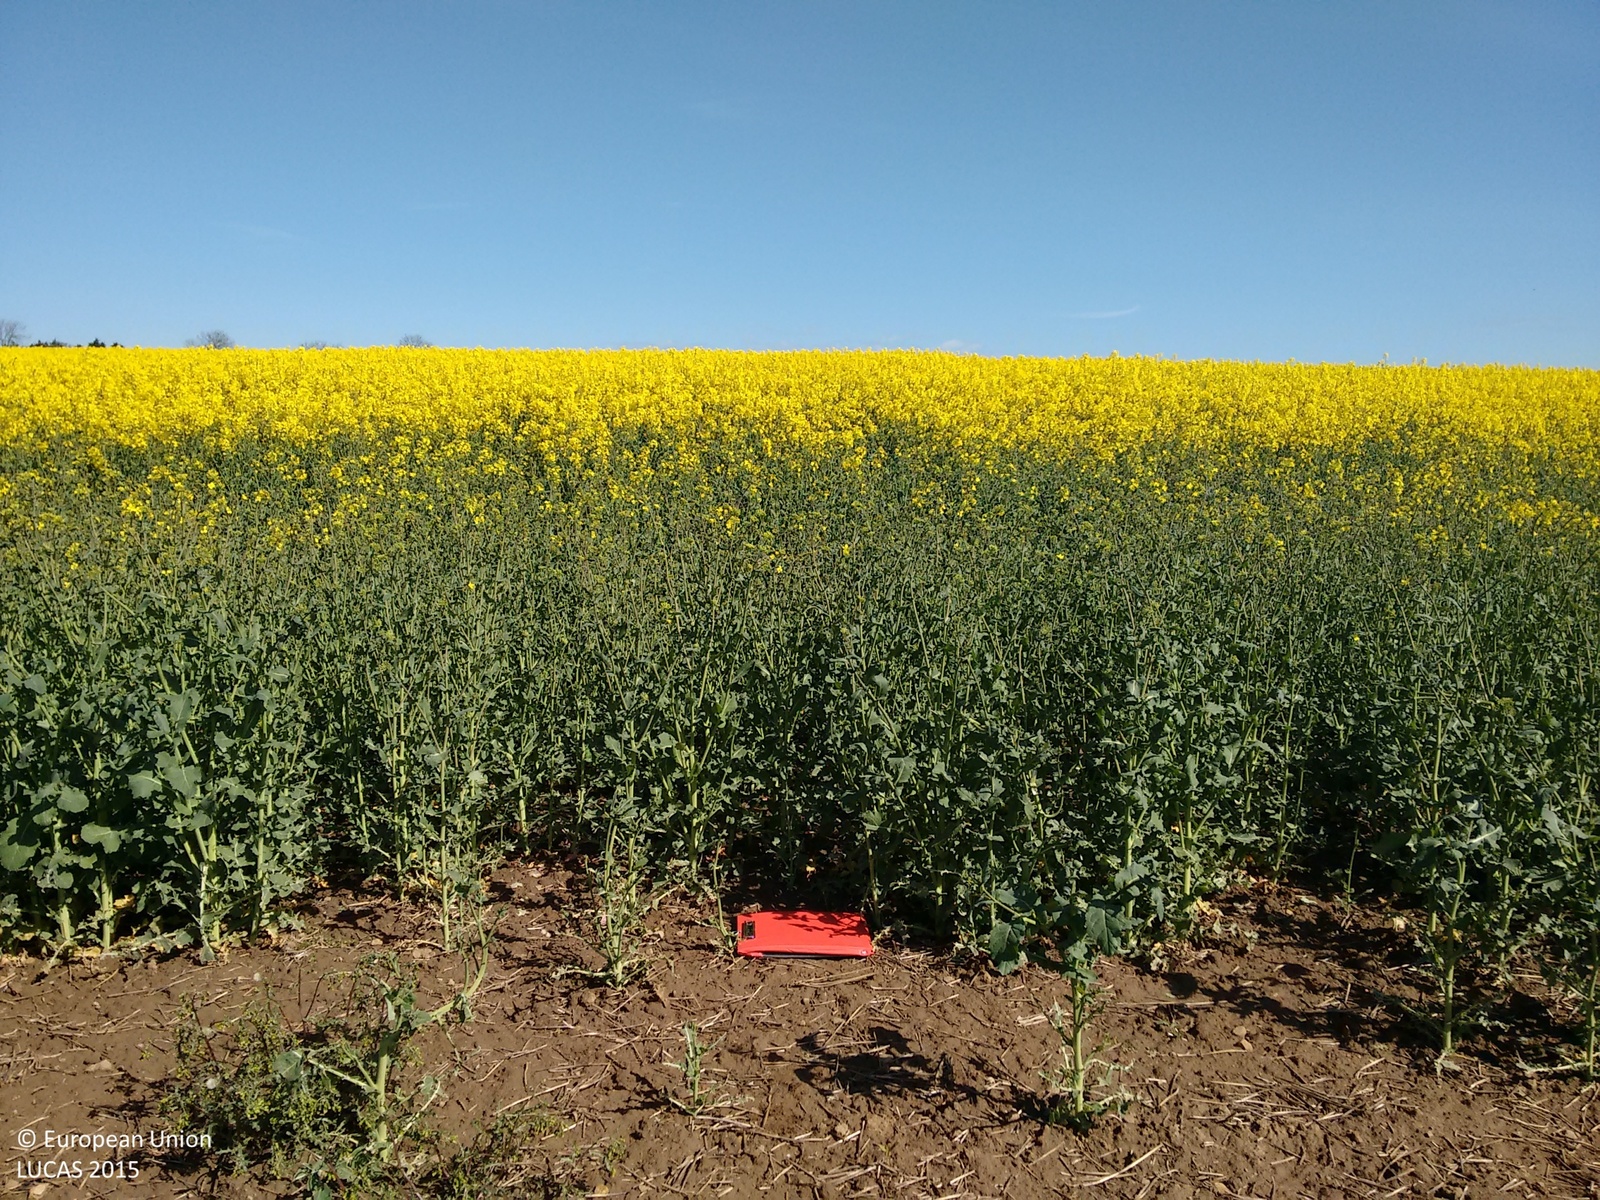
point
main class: Cropland
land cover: Rape and turnip rape
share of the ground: > 75 %
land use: Agriculture (excluding fallow land and kitchen gardens)
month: May
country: GB
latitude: 55.2320
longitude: -1.7009
